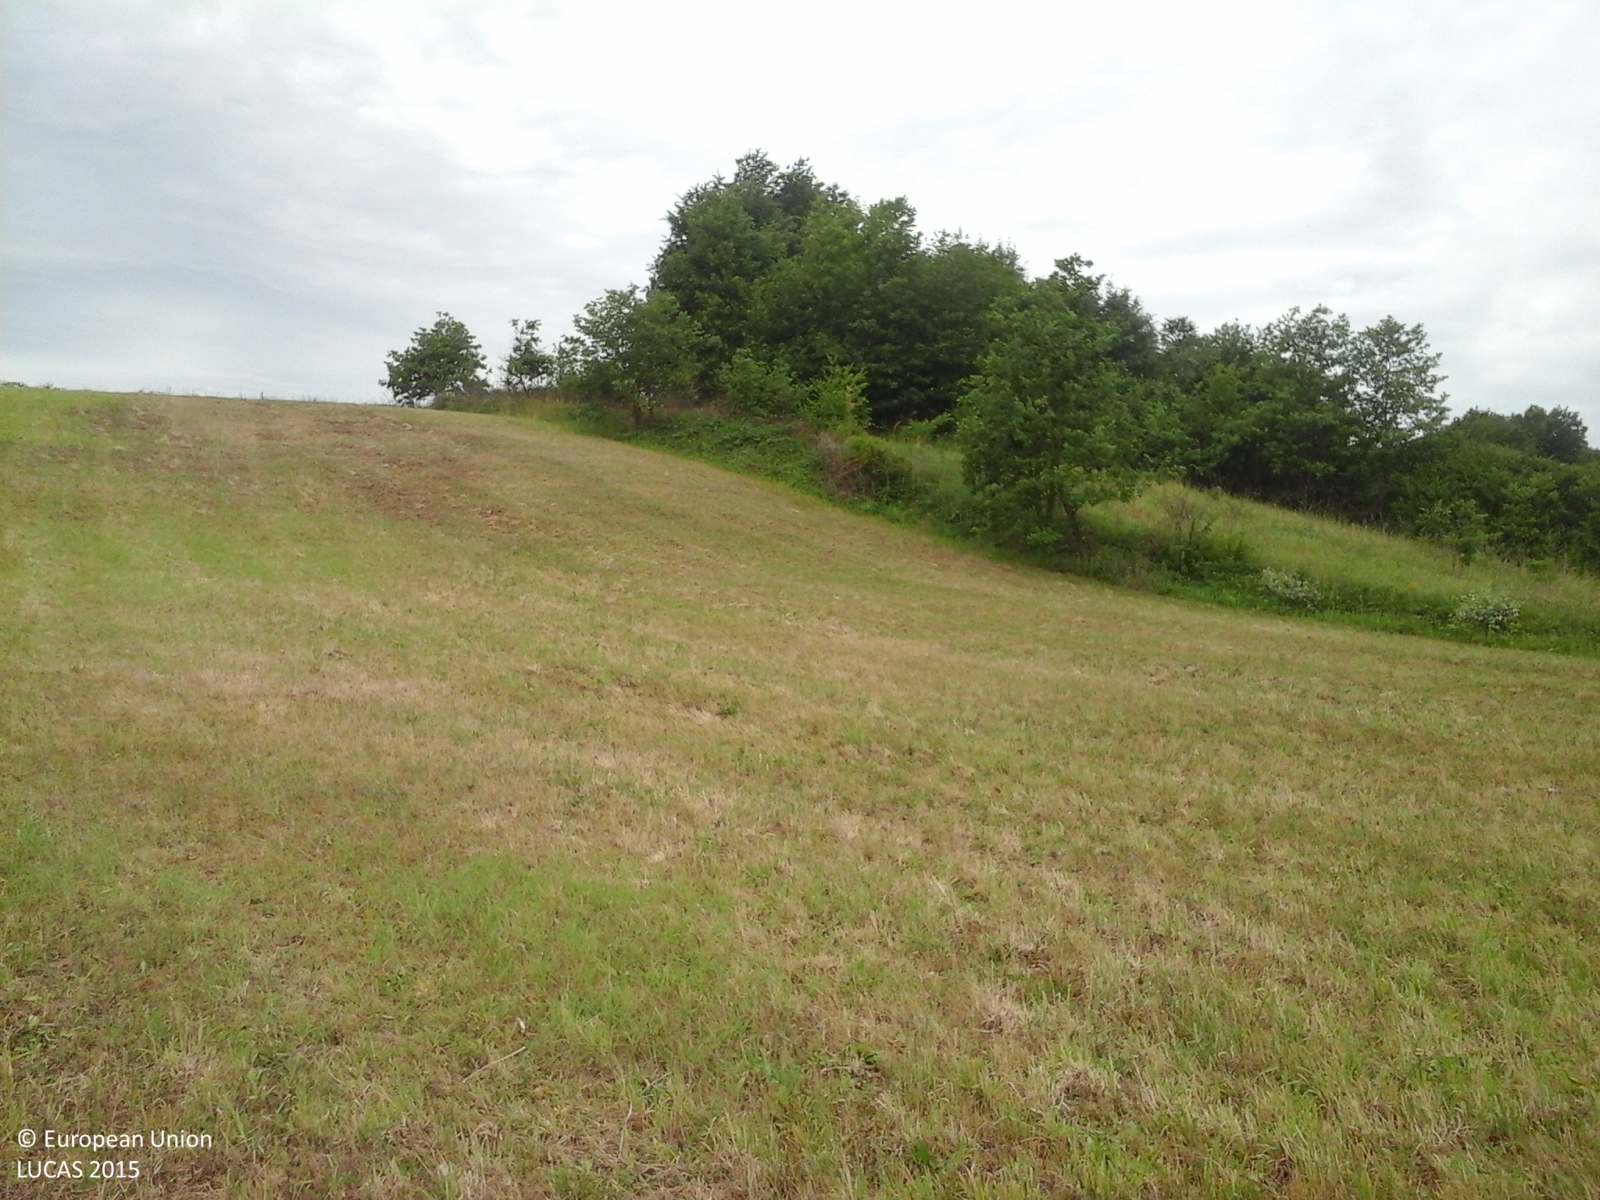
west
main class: Grassland
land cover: Spontaneously vegetated surfaces
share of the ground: > 75 %
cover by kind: herbaceous plants 100 %
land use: Agriculture (excluding fallow land and kitchen gardens)
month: June
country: IT
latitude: 41.7936
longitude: 13.0813
